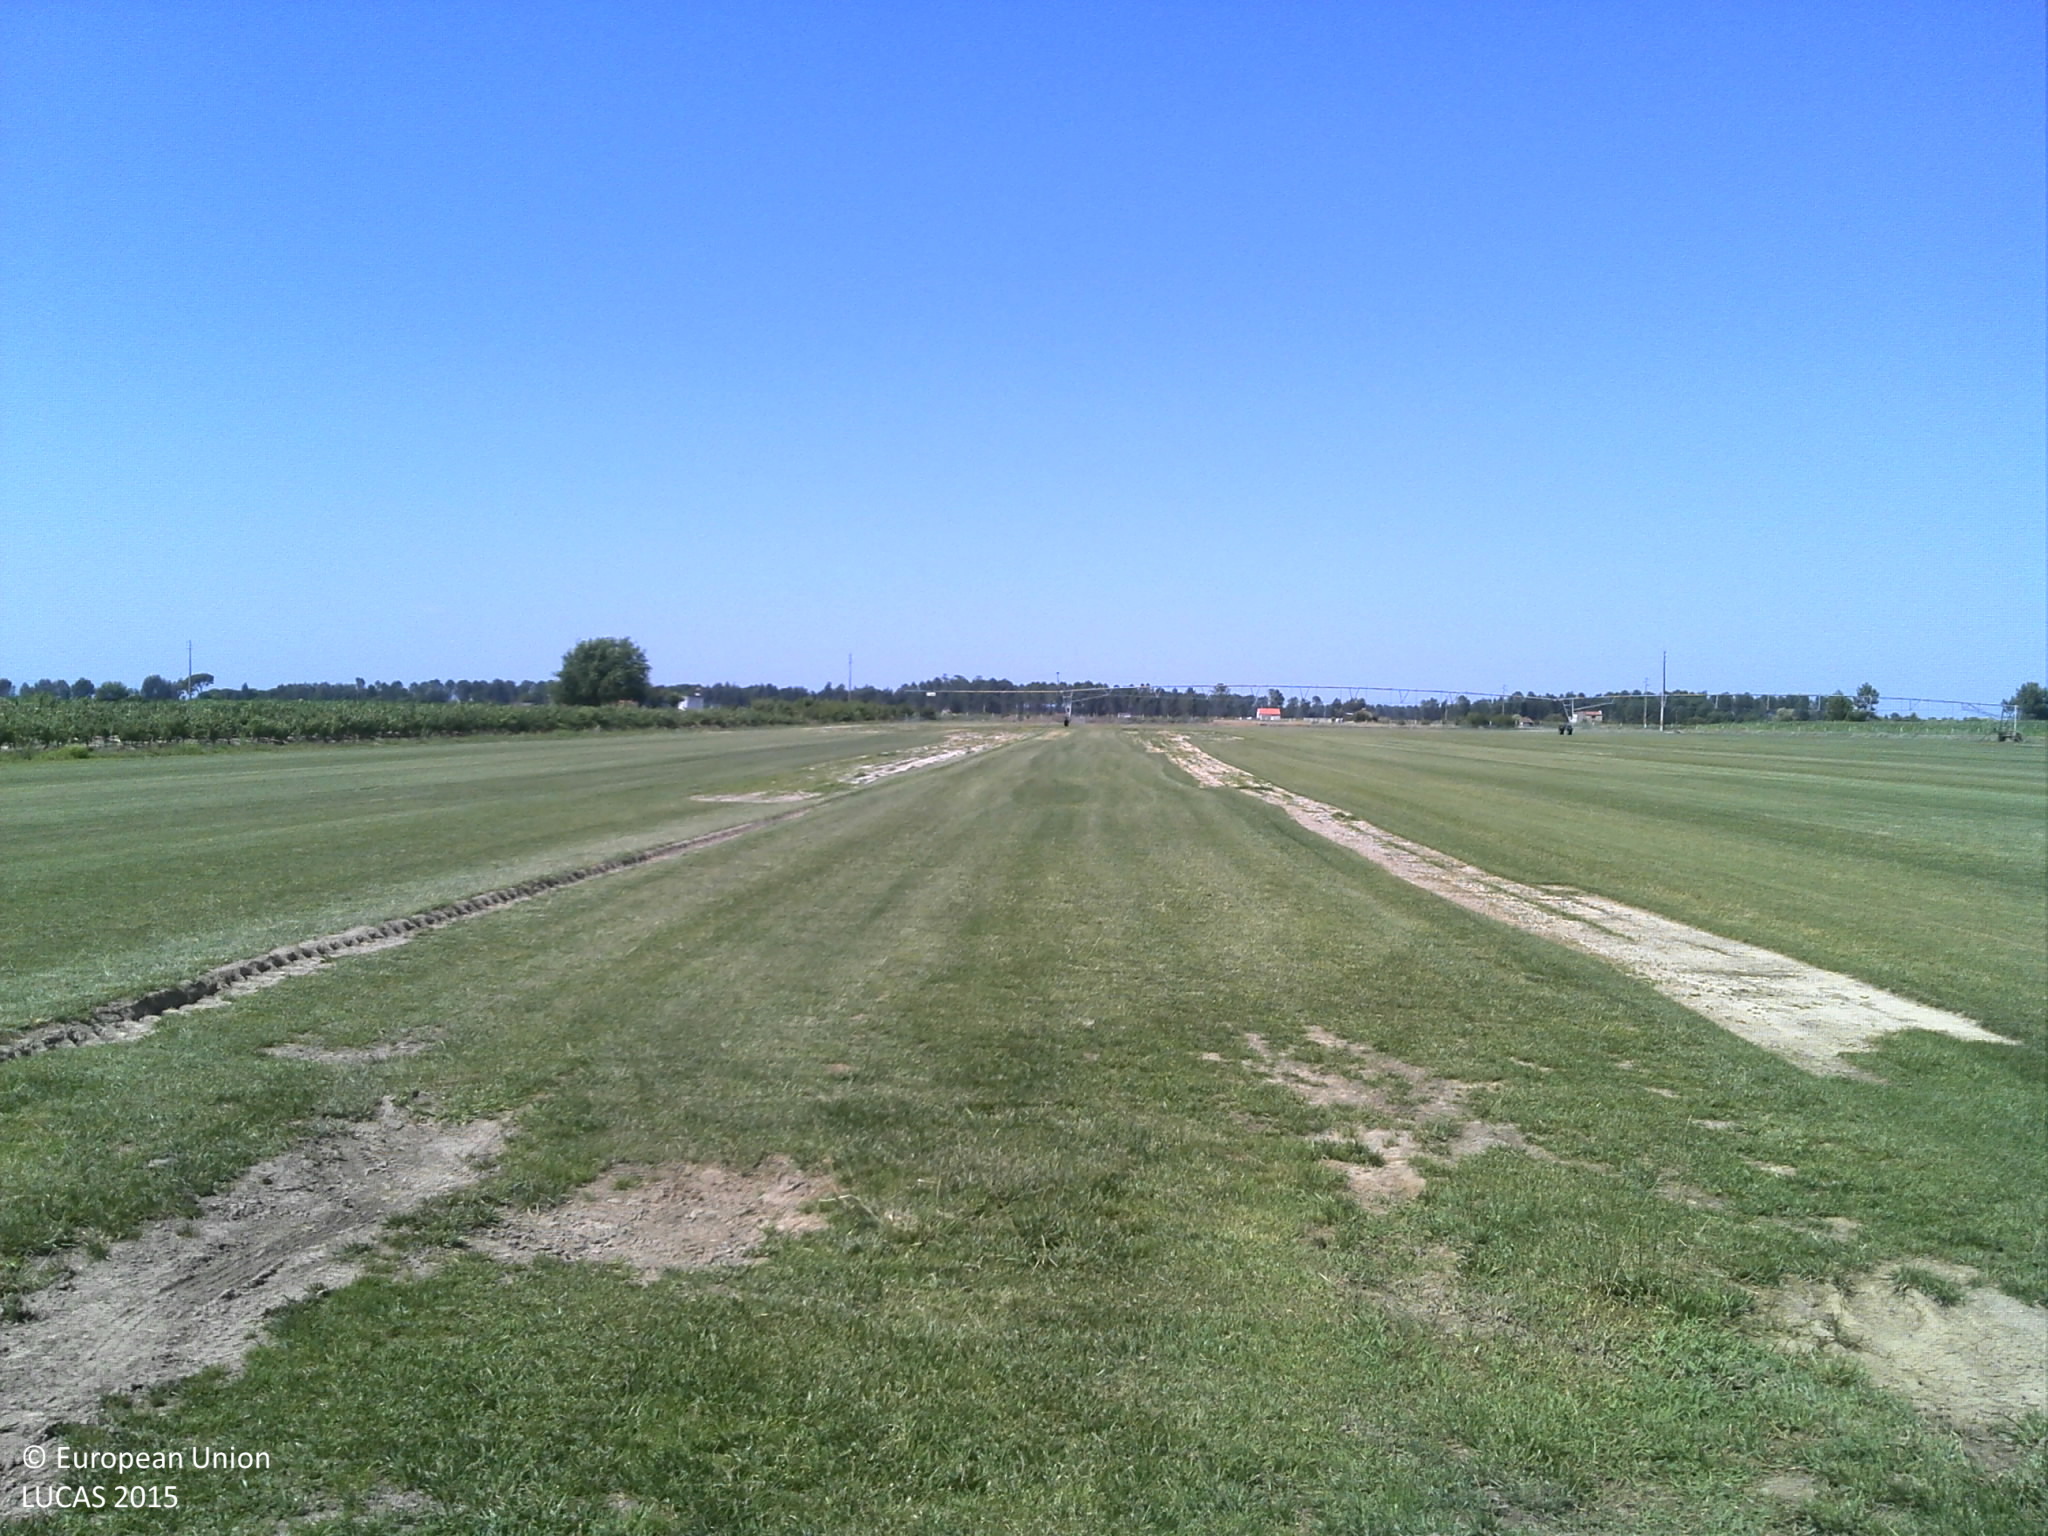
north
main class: Cropland
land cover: Nurseries
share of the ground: > 75 %
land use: Agriculture (excluding fallow land and kitchen gardens)
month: June
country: PT
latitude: 39.1478
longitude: -8.6408
